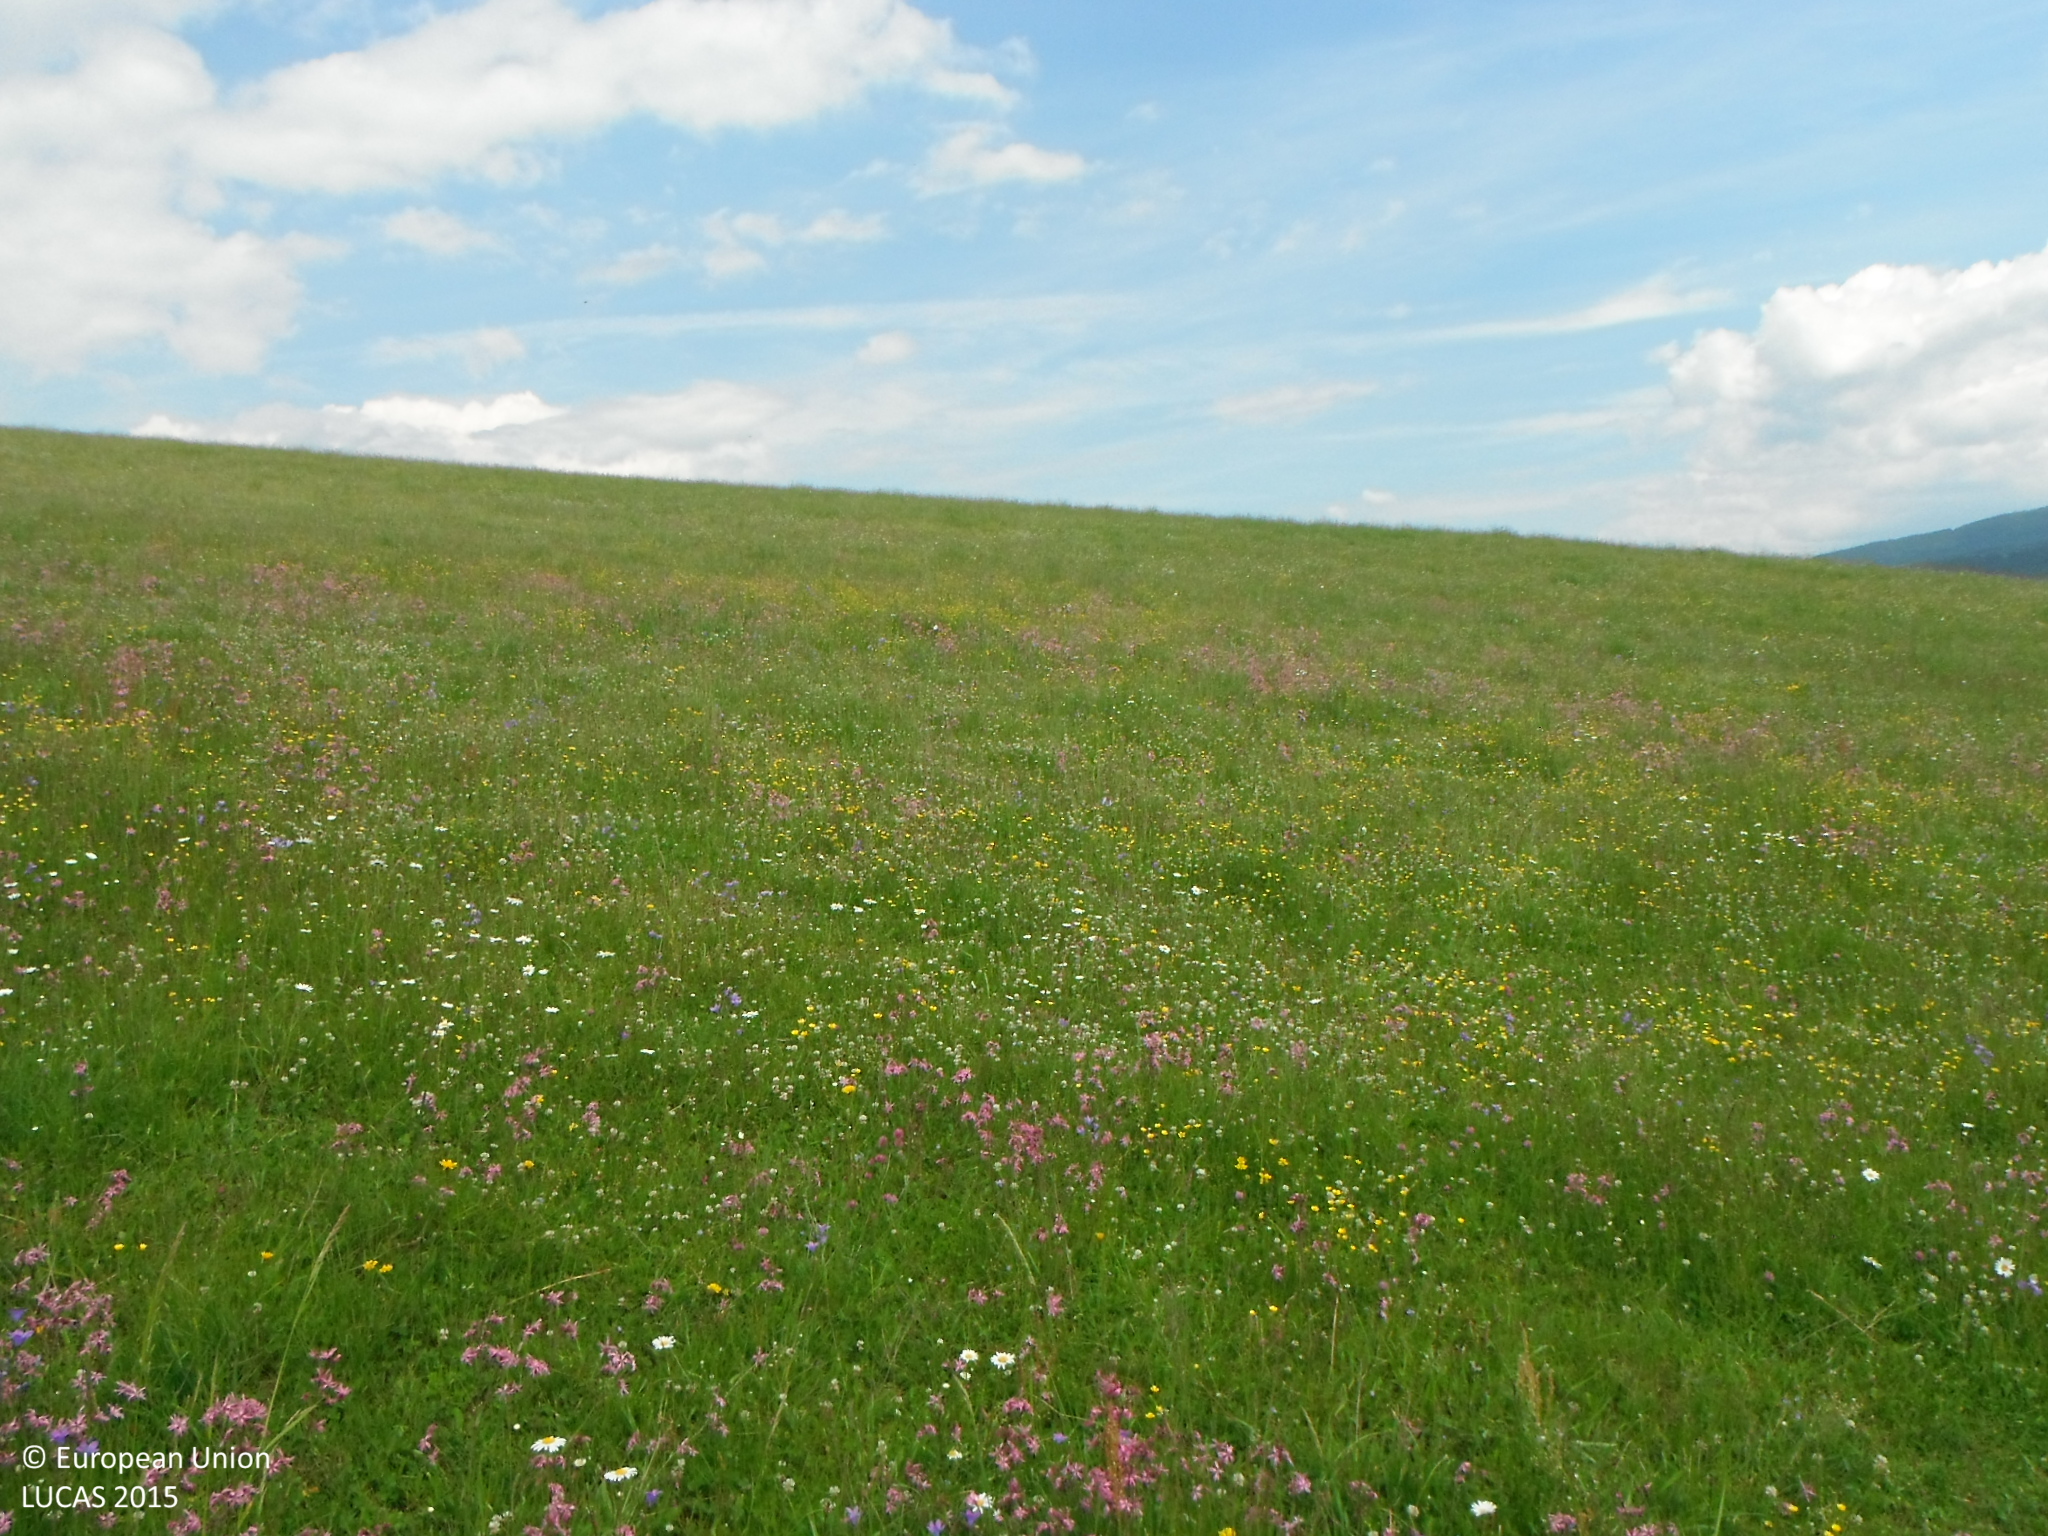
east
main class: Grassland
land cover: Grassland without tree/shrub cover
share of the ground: > 75 %
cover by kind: herbaceous plants 100 %
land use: Agriculture (excluding fallow land and kitchen gardens)
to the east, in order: Grassland without tree/shrub cover
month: June
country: SK
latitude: 48.8266
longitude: 19.7125
